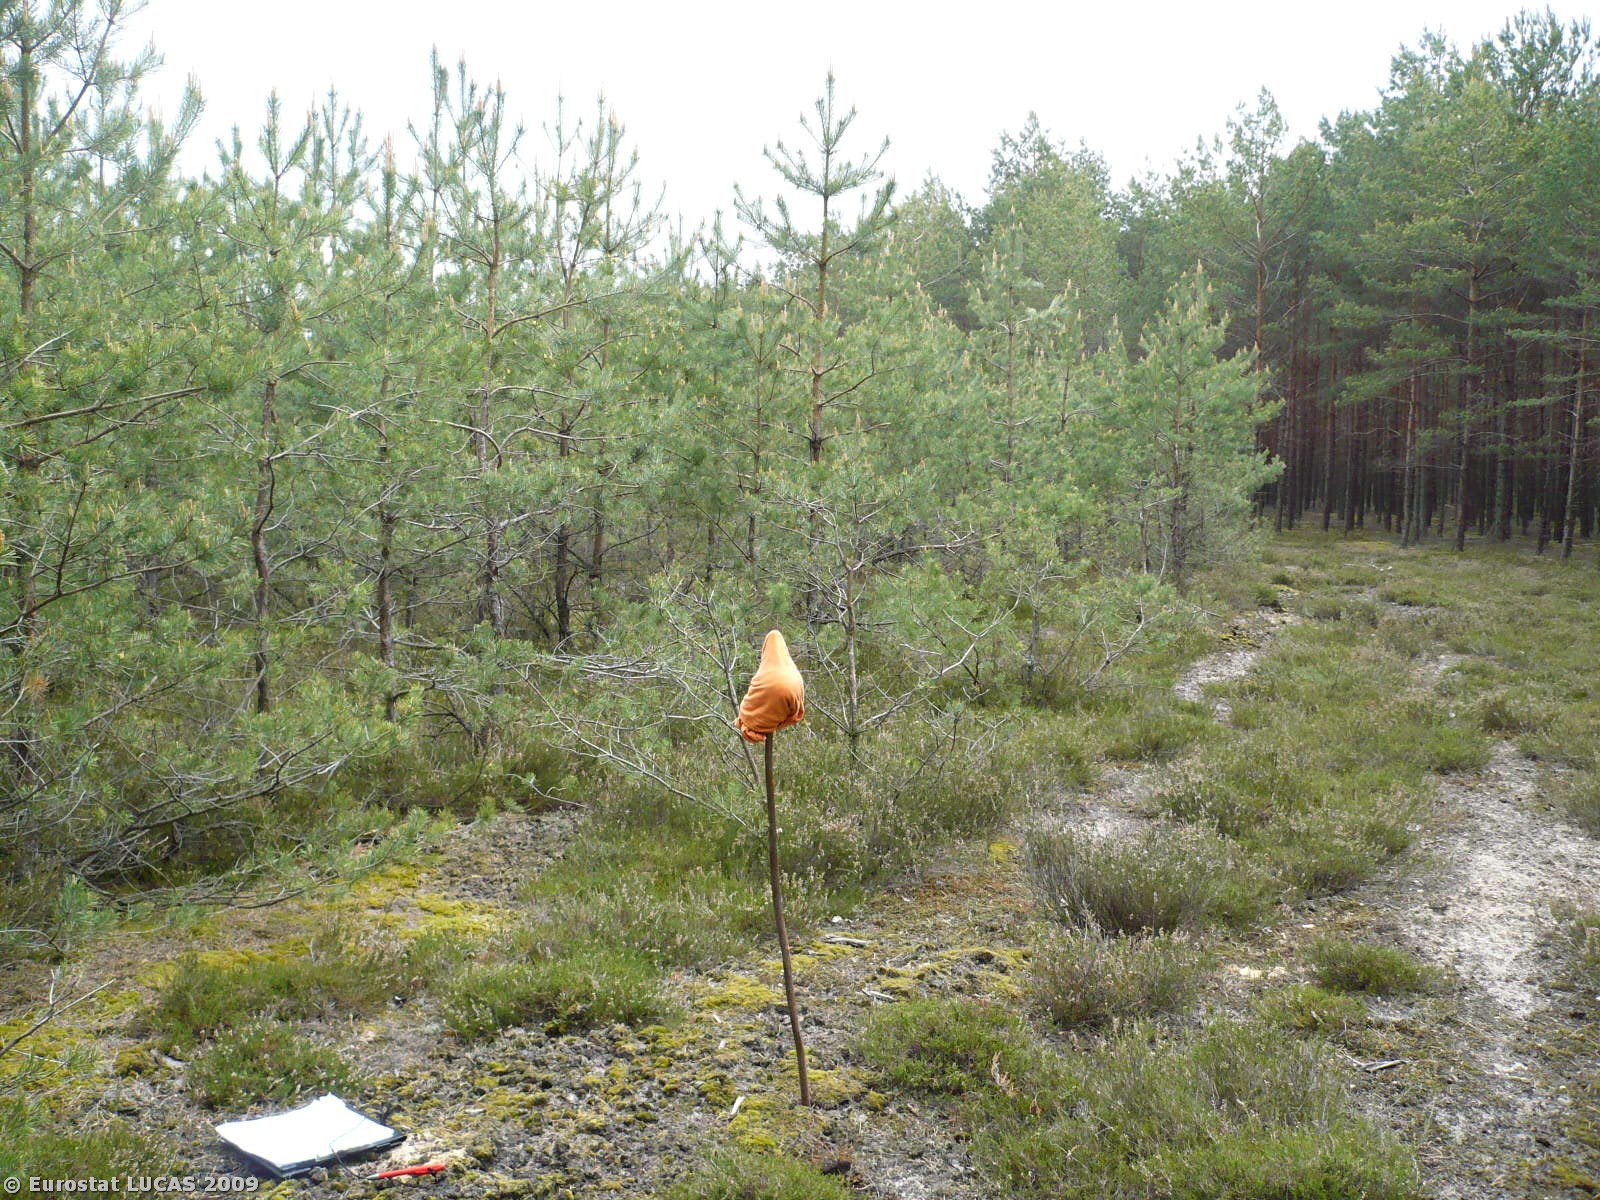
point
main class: Woodland
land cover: Coniferous woodland
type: hemiboreal forest and nemoral coniferous forest and mixed broadleaved-coniferous forest
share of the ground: 50 - 75 %
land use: Forestry
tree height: > 5 m
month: May
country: PL
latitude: 51.8704
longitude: 15.1300
